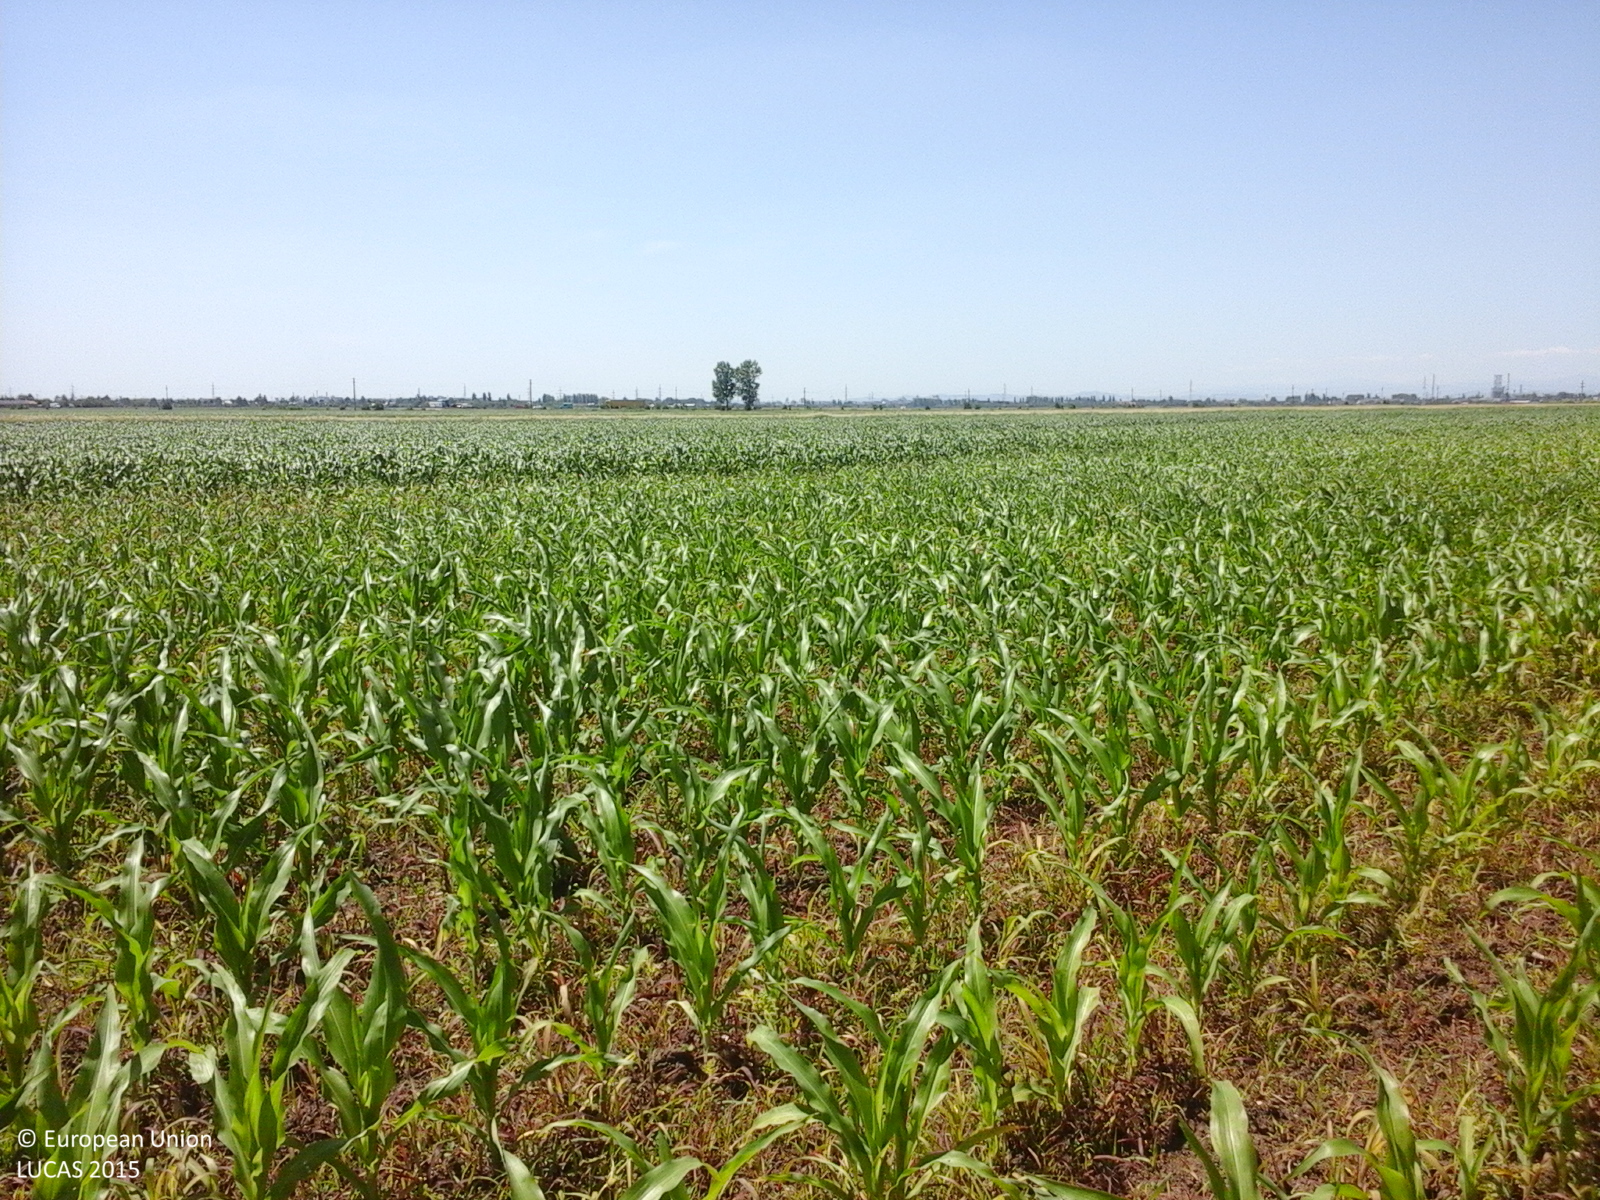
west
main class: Cropland
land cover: Maize
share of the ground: 50 - 75 %
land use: Agriculture (excluding fallow land and kitchen gardens)
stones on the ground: < 10 %
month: June
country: RO
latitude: 44.9180
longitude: 26.1095
